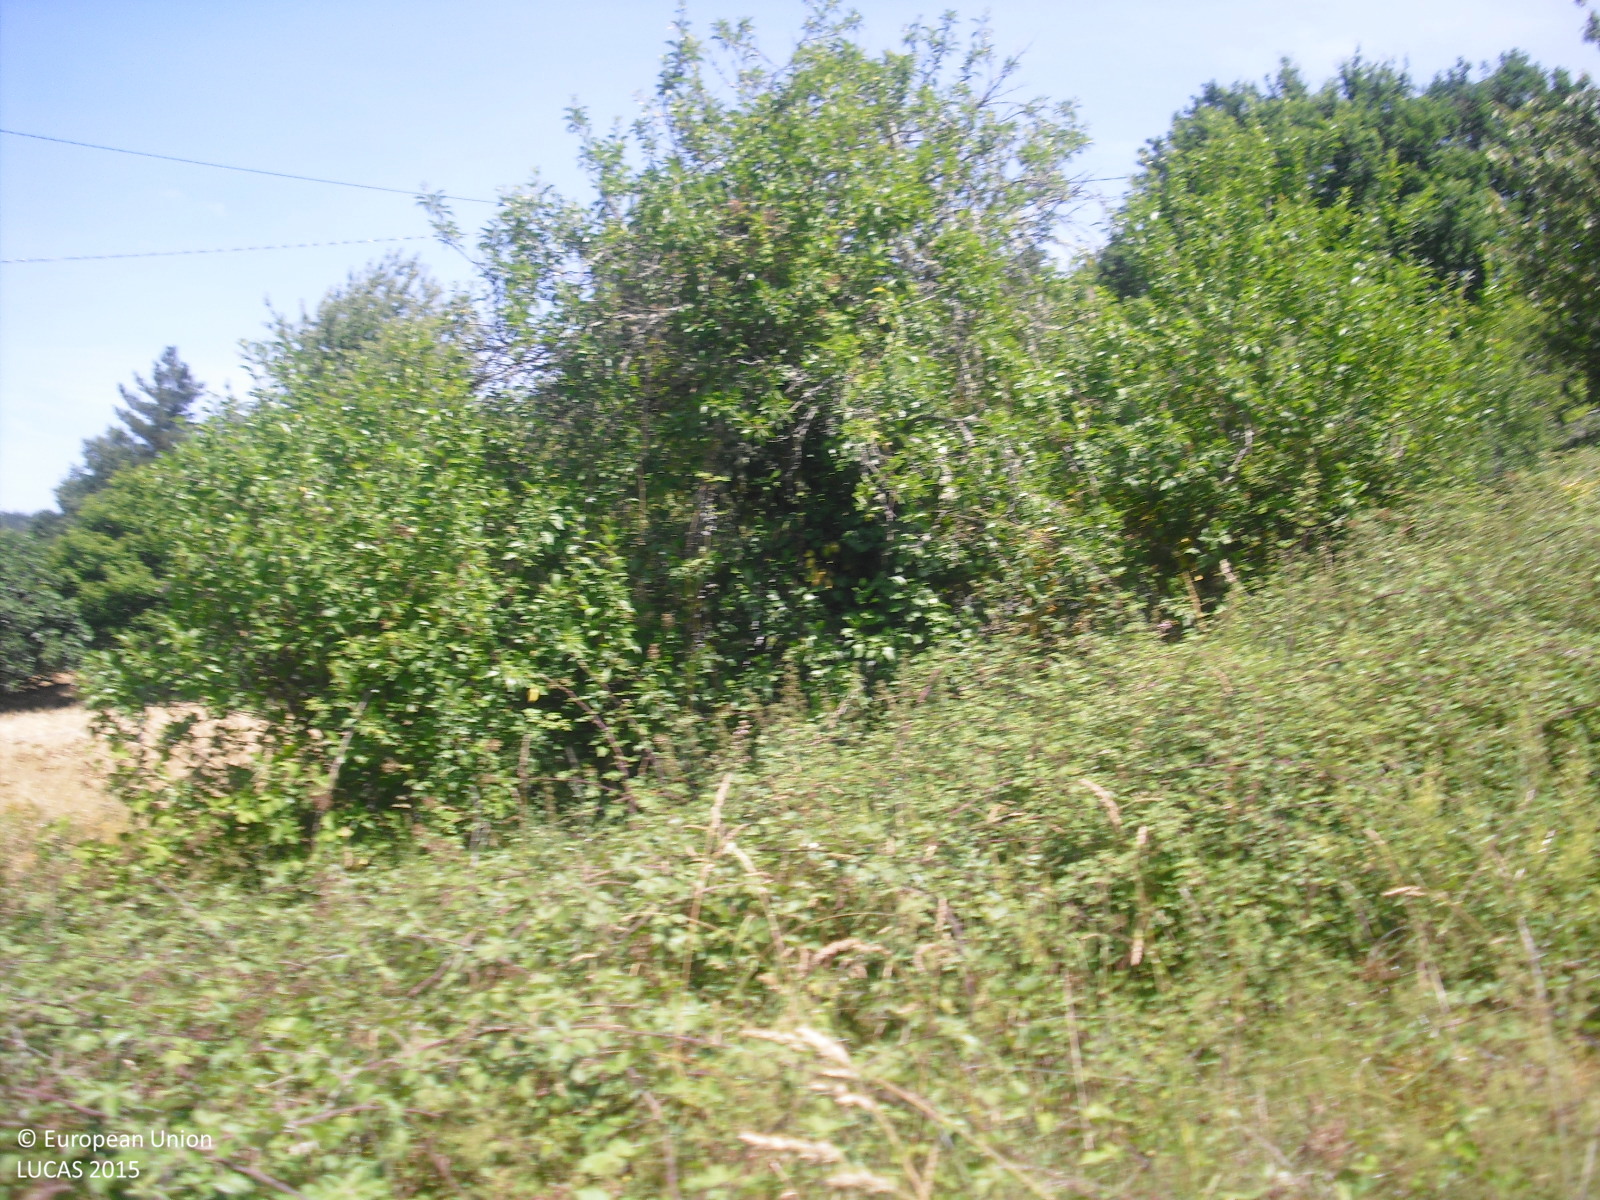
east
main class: Shrubland
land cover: Shrubland with sparse tree cover
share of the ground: 50 - 75 %
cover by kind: shrubs 75 %, herbaceous plants 20 %, broadleaved forest trees 5 %
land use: Abandoned areas
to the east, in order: Shrubland with sparse tree cover; Dry stone walls; Shruby margins; Single bushes/trees; Electric lines; Shruby margins; Paved roads, cycling and walking lanes; Shruby margins; Electric lines; Dry stone walls; Fences; Common wheat; Shruby margins; Groves; Fences; Shruby margins; Other bare soil; Grassland with sparse tree/shrub cover; Dry stone walls; Grassland without tree/shrub cover; Fences; Shruby margins; Ditches and canals; Paved roads, cycling and walking lanes; Shruby margins; Ditches and canals; Shruby margins; Pine dominated mixed woodland; Pine dominated coniferous woodland; Fences; Shrubland without tree cover; Grassland without tree/shrub cover; Shruby margins; Broadleaved woodland; Tracks; Shrubland with sparse tree cover
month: July
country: ES
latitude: 42.4846
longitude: -7.4772
